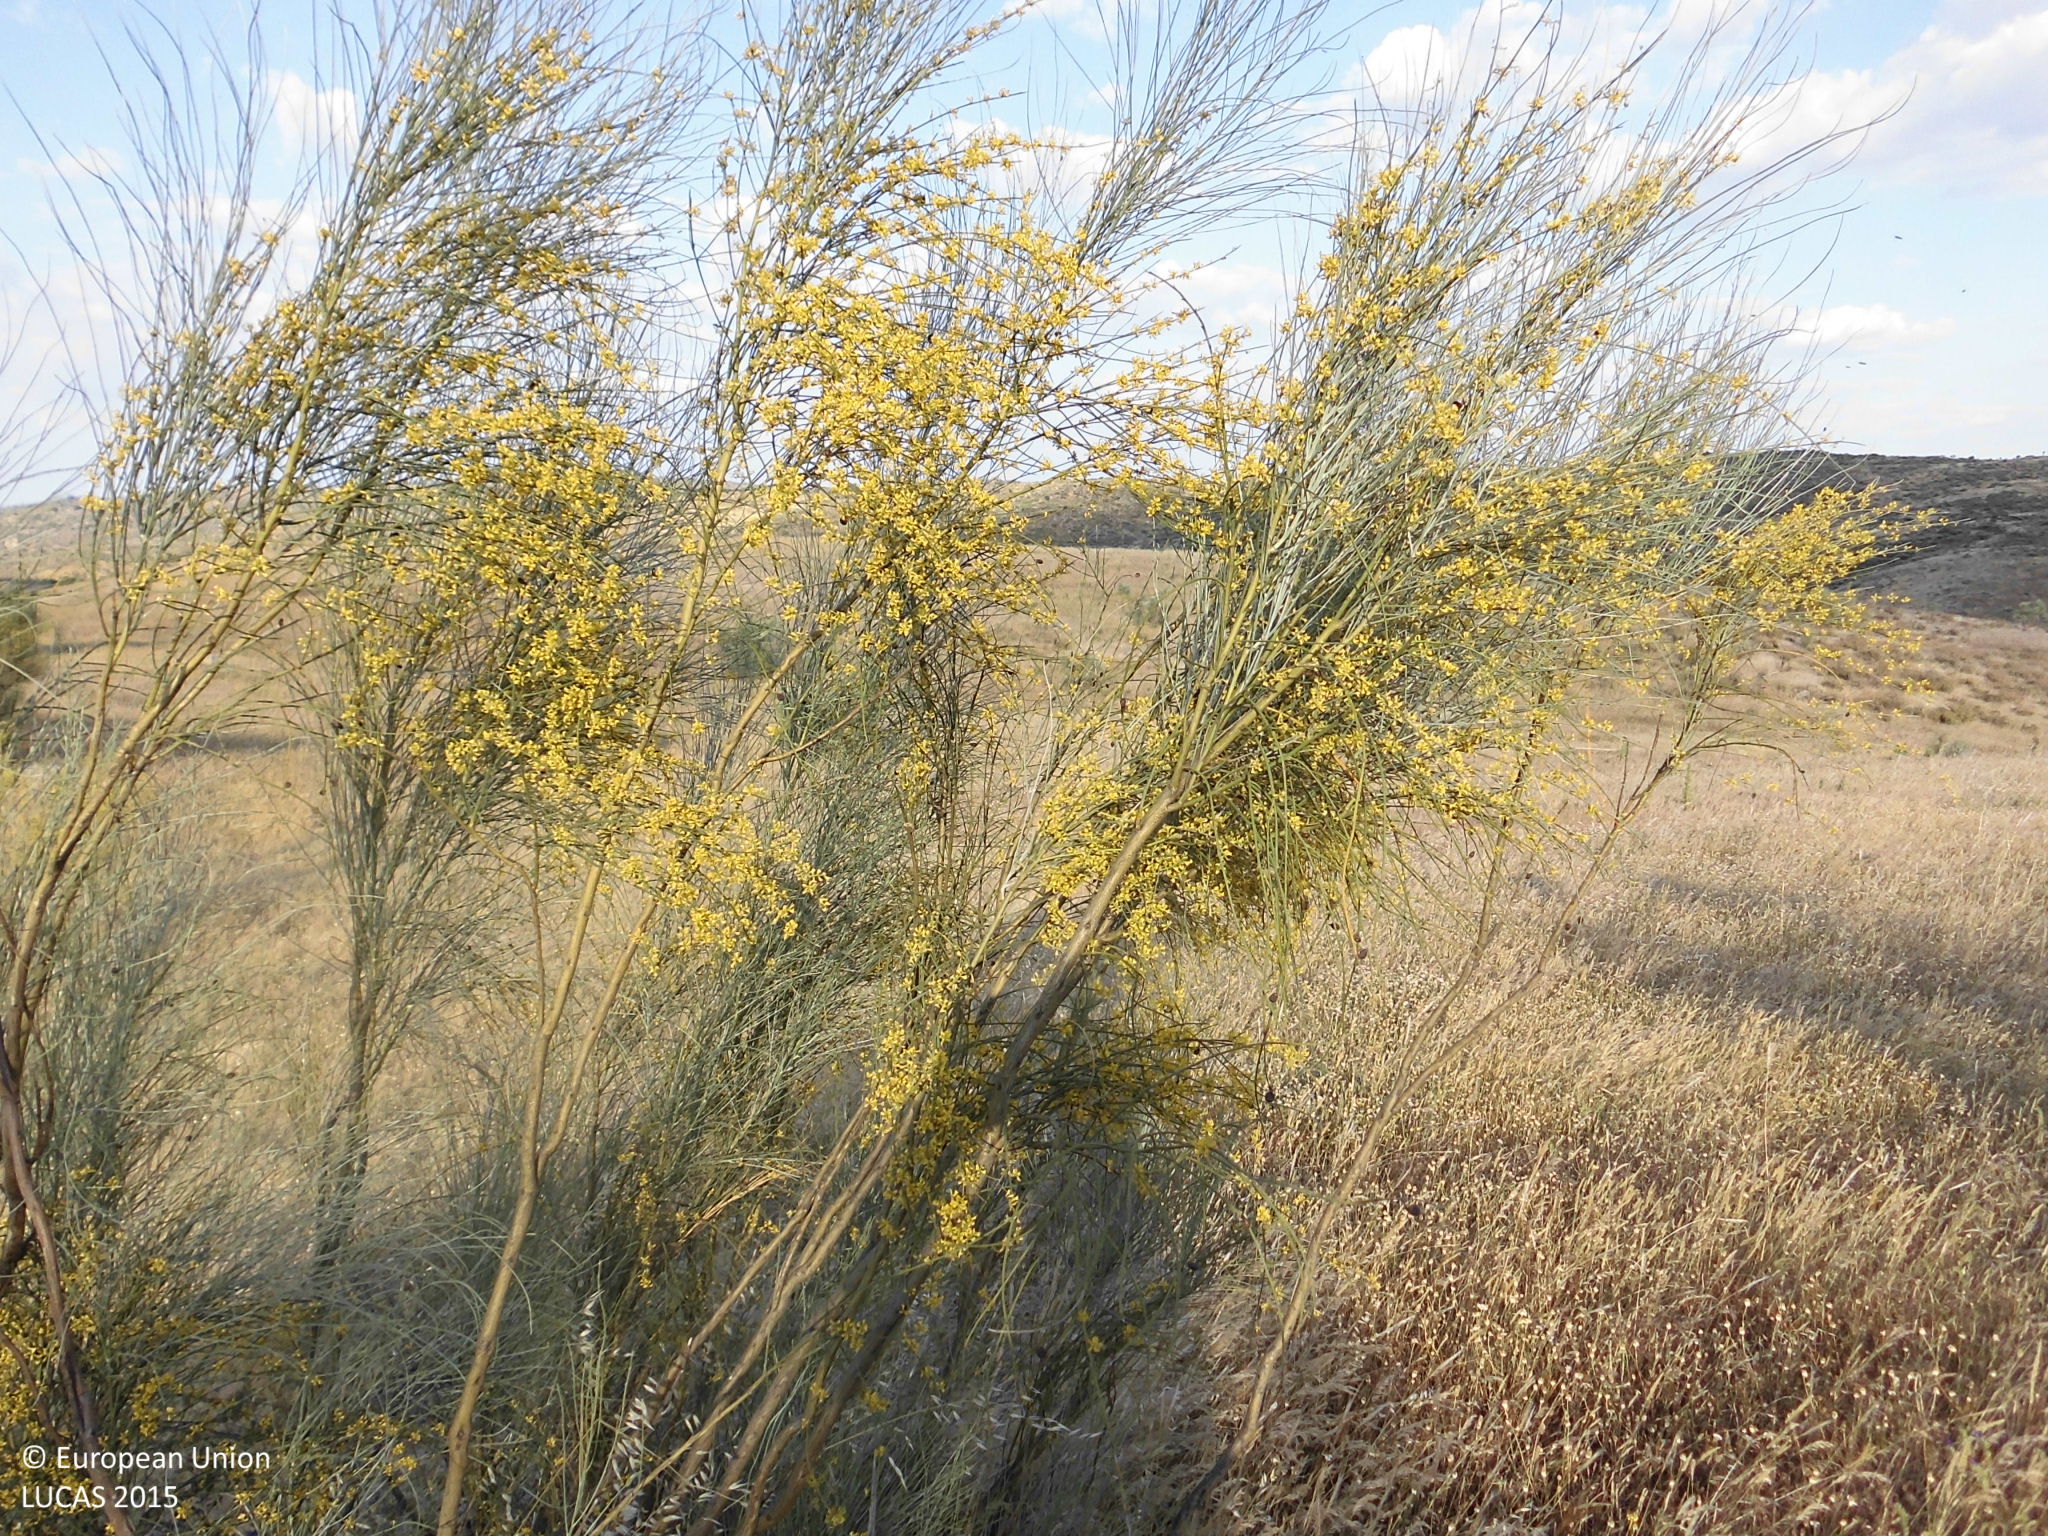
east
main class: Grassland
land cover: Grassland without tree/shrub cover
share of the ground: > 75 %
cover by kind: herbaceous plants 95 %, shrubs 5 %
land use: Agriculture (excluding fallow land and kitchen gardens)
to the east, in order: Grassland without tree/shrub cover; Rivers and streams; Shrubland without tree cover
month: May
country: ES
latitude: 39.5937
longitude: -6.6221
